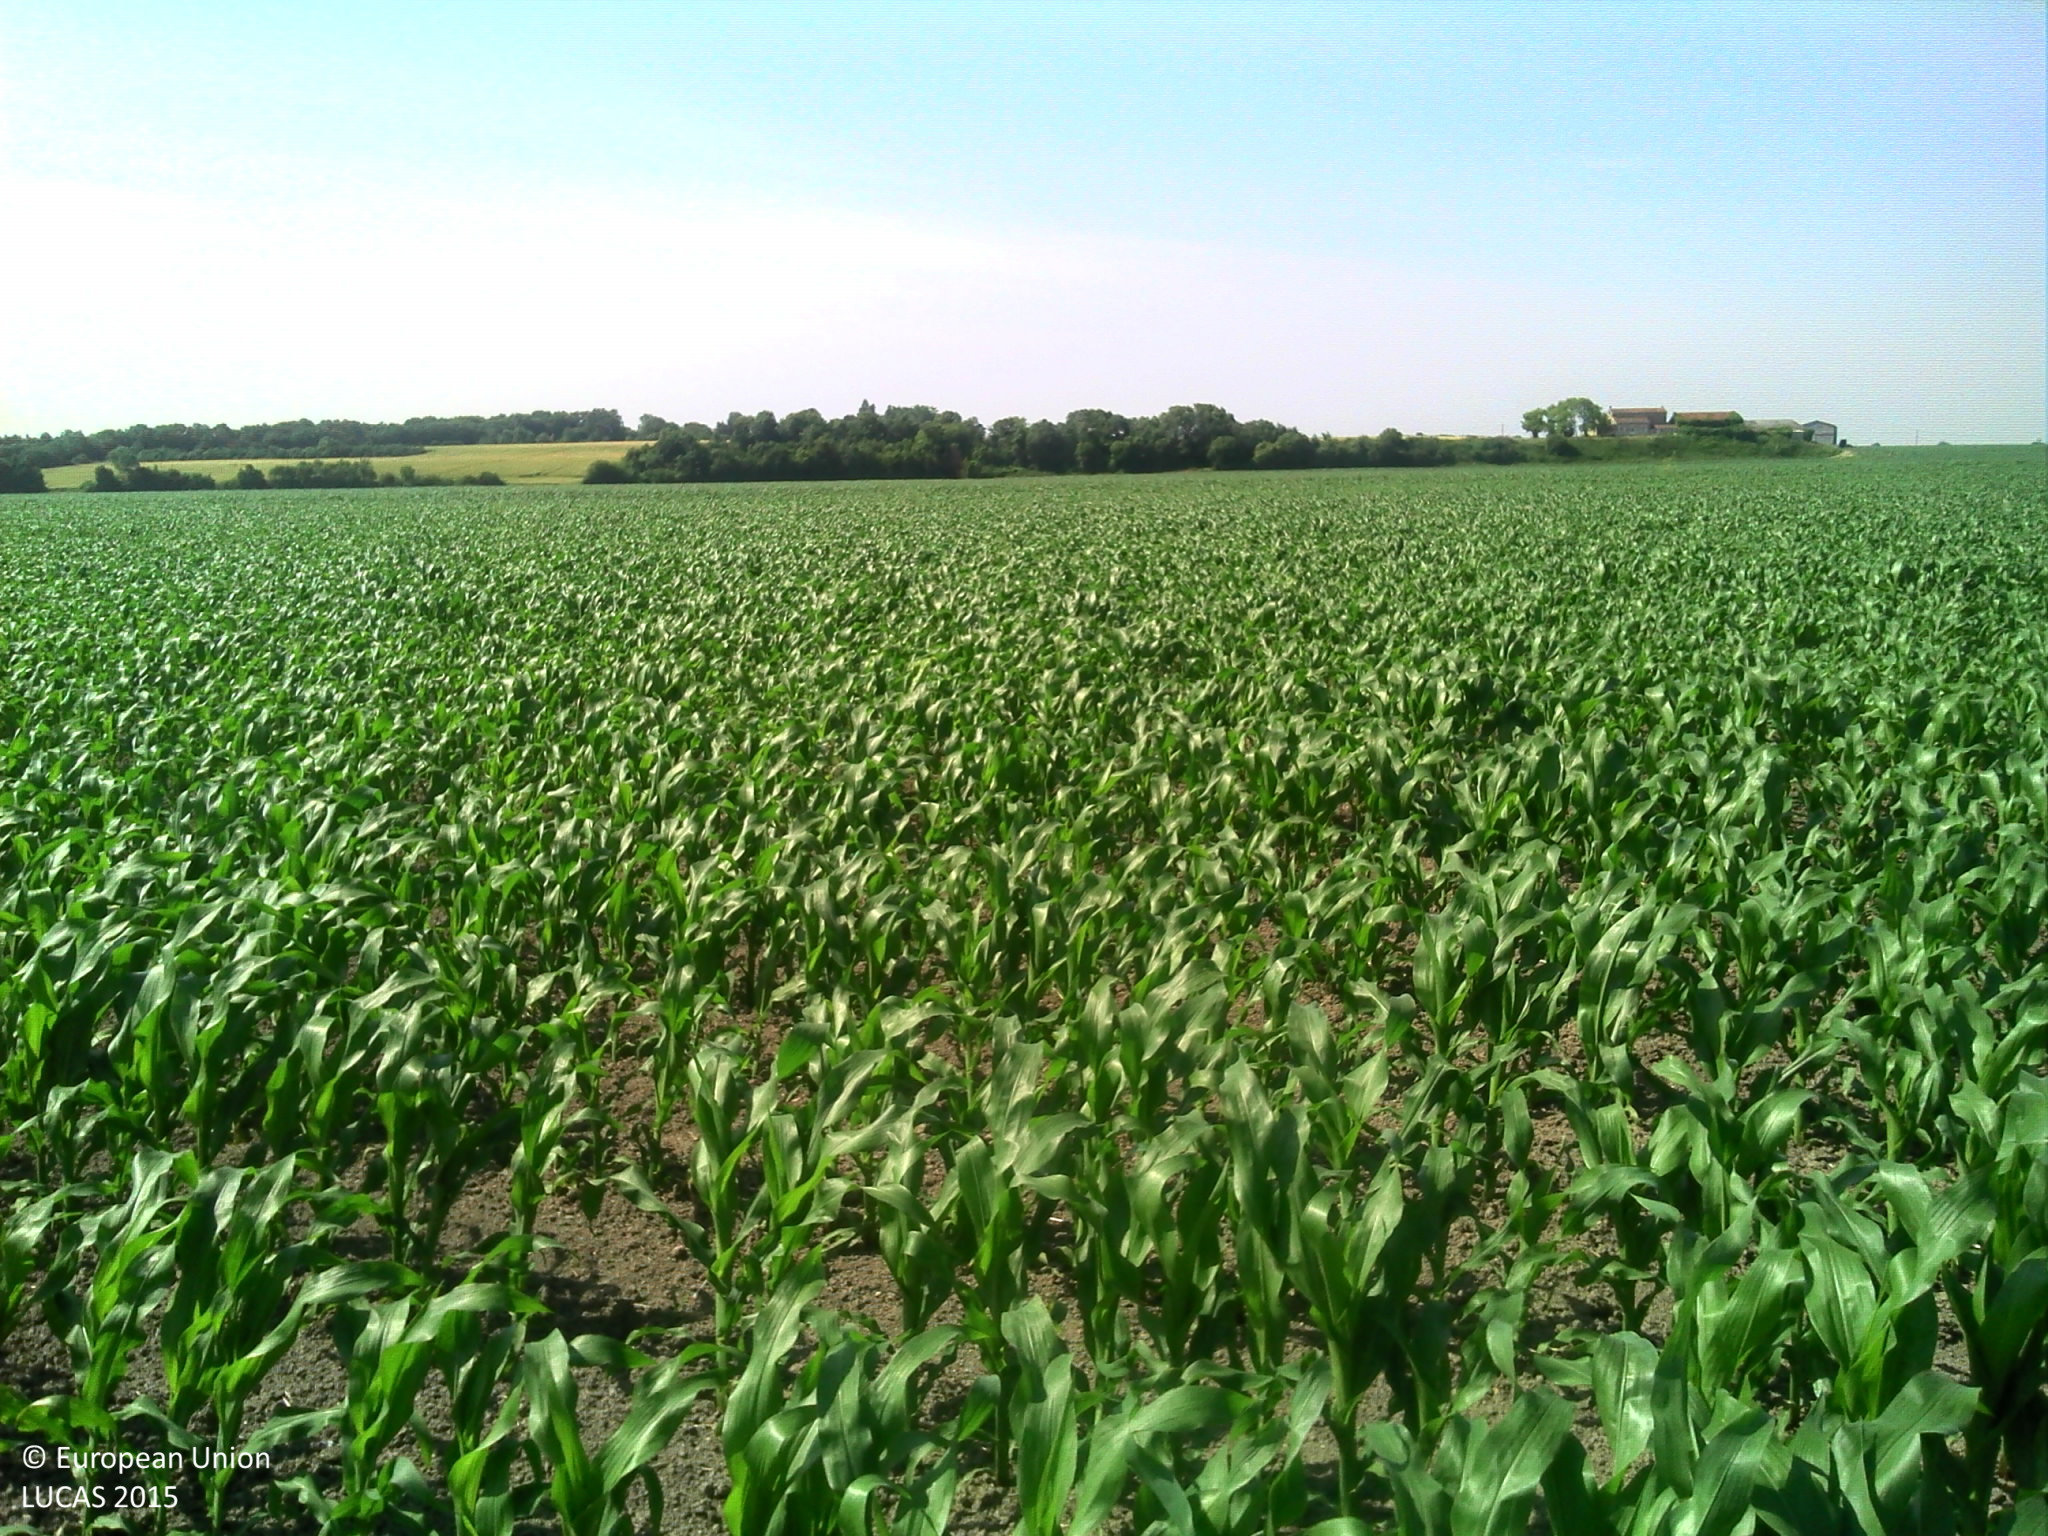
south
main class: Cropland
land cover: Maize
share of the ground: 50 - 75 %
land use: Agriculture (excluding fallow land and kitchen gardens)
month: June
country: FR
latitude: 46.0036
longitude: -0.9665
